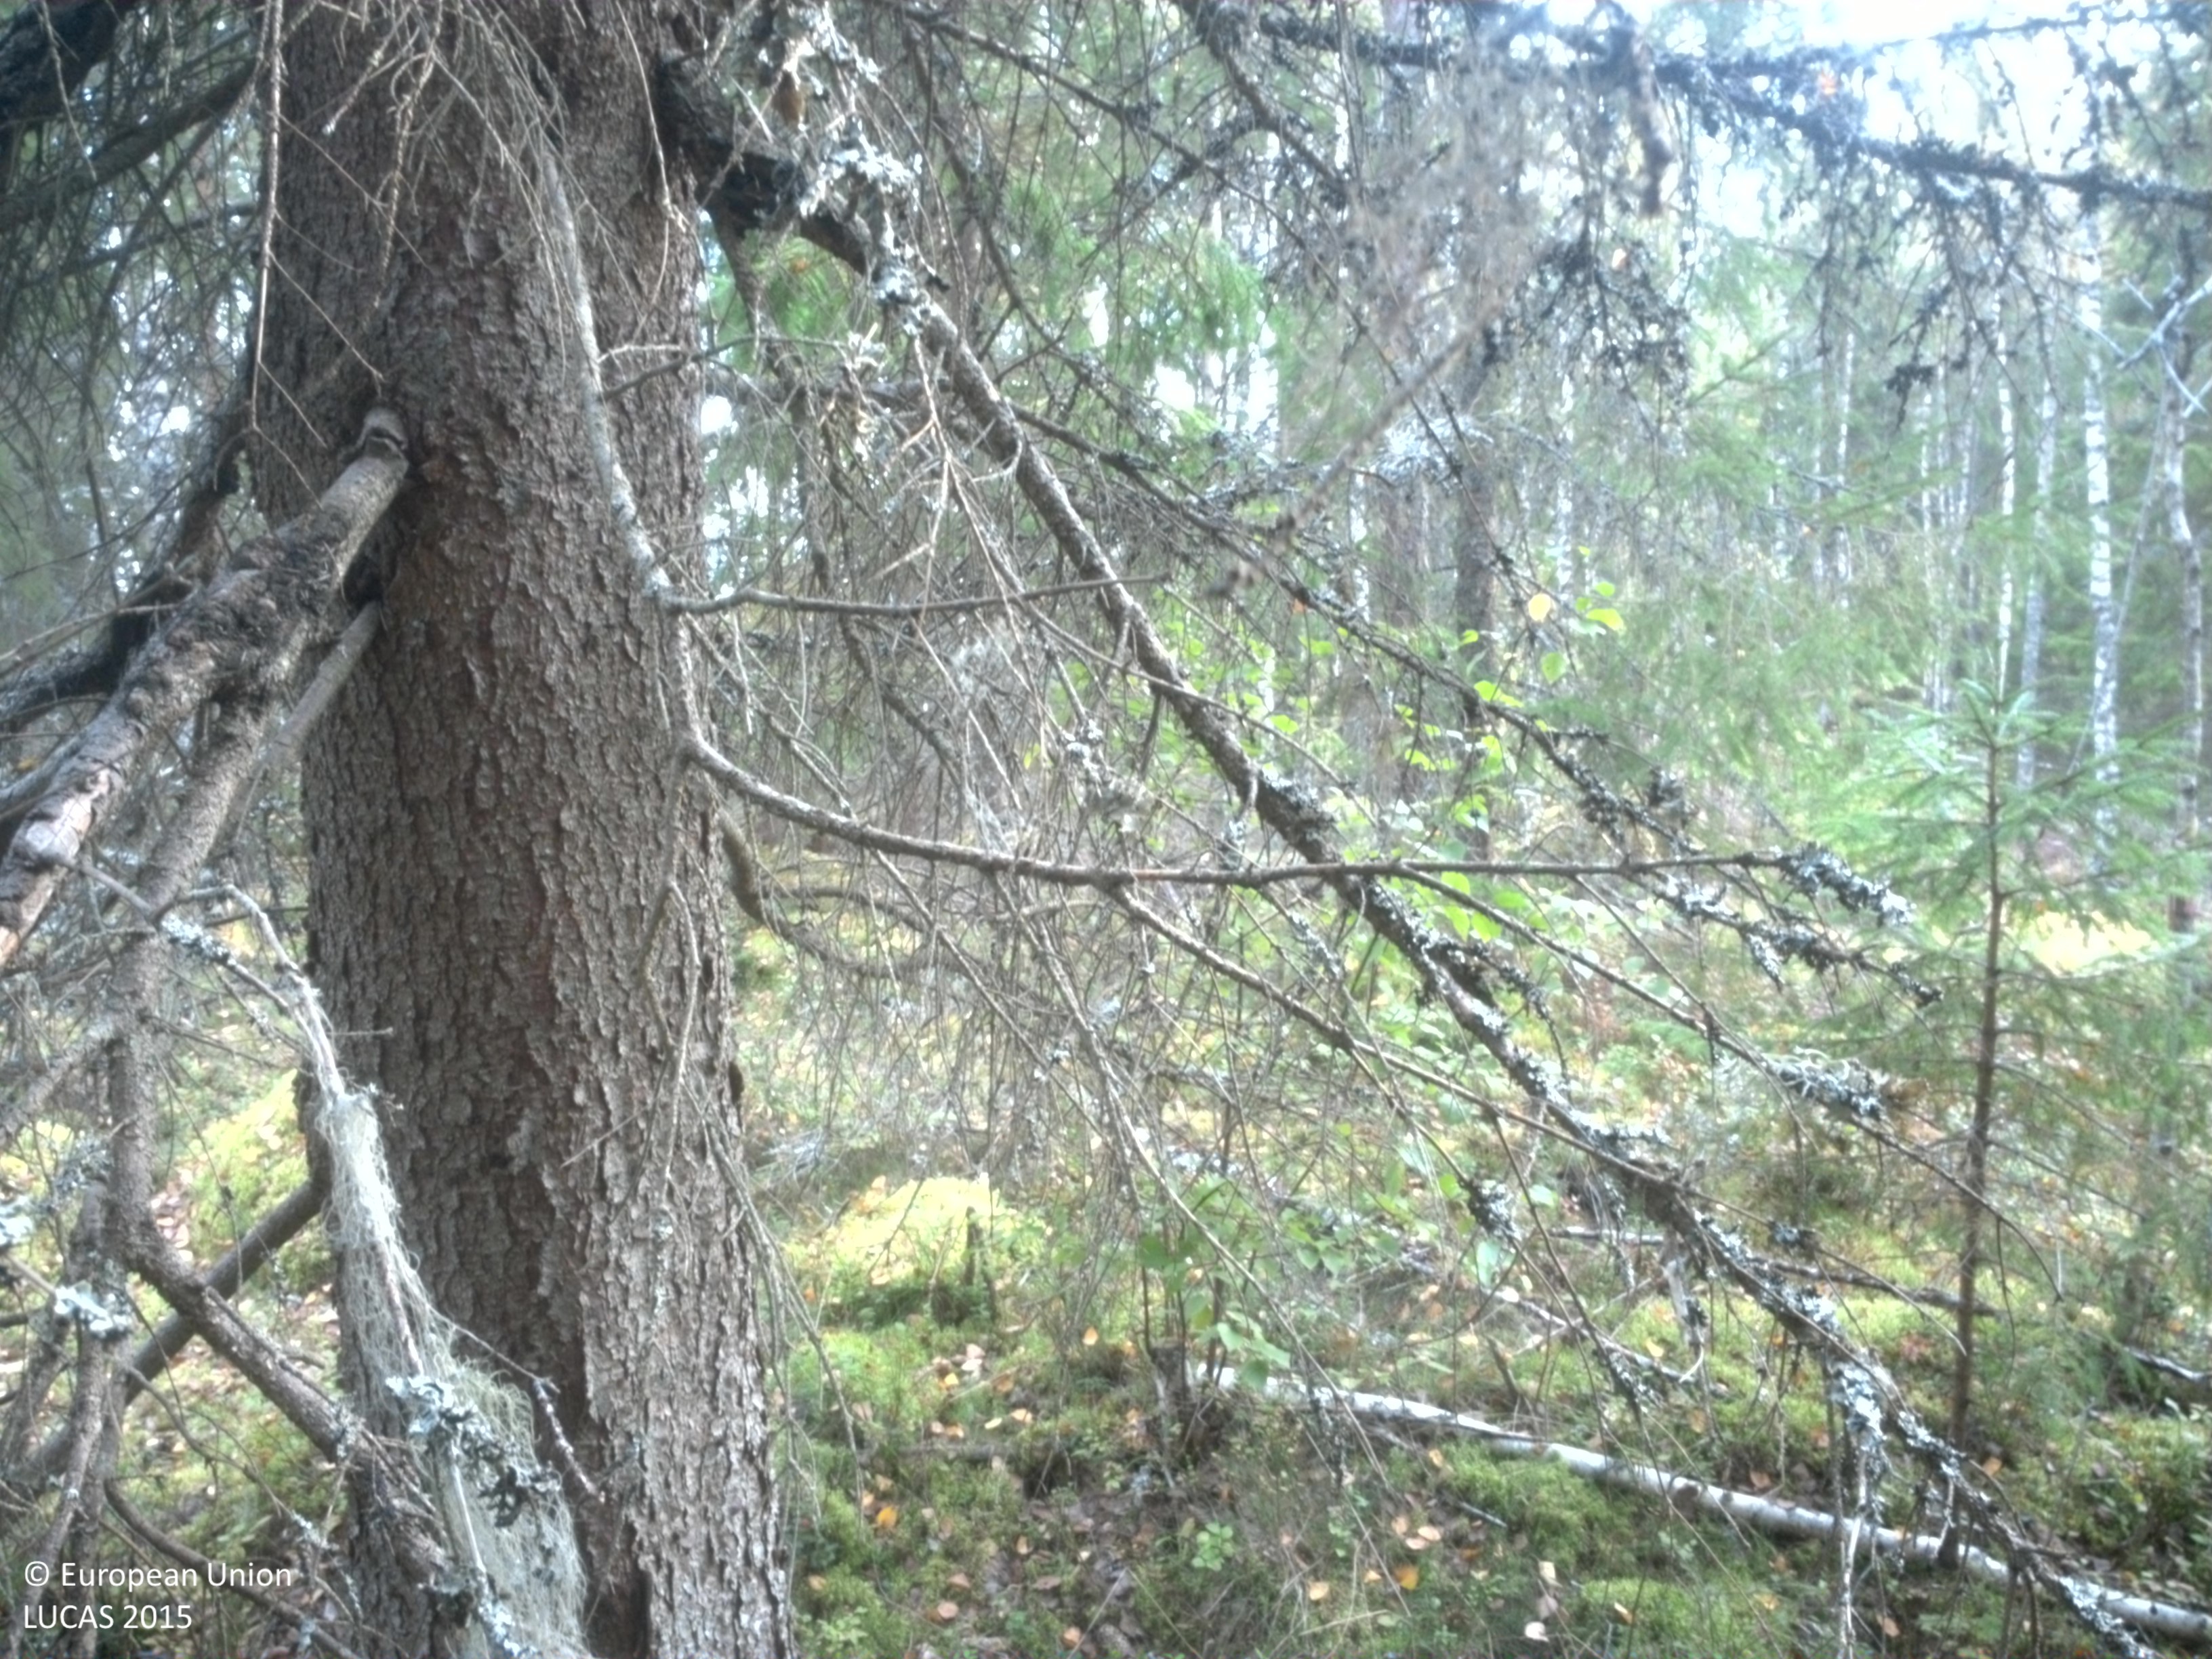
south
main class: Woodland
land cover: Spruce dominated mixed woodland
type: boreal forest
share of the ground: 50 - 75 %
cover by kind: coniferous forest trees 40 %, broadleaved forest trees 25 %, shrubs 20 %, lichens and mosses 10 %, consolidated bare surface 5 %
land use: Forestry
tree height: > 5 m
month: September
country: SE
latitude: 59.5338
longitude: 15.4547
